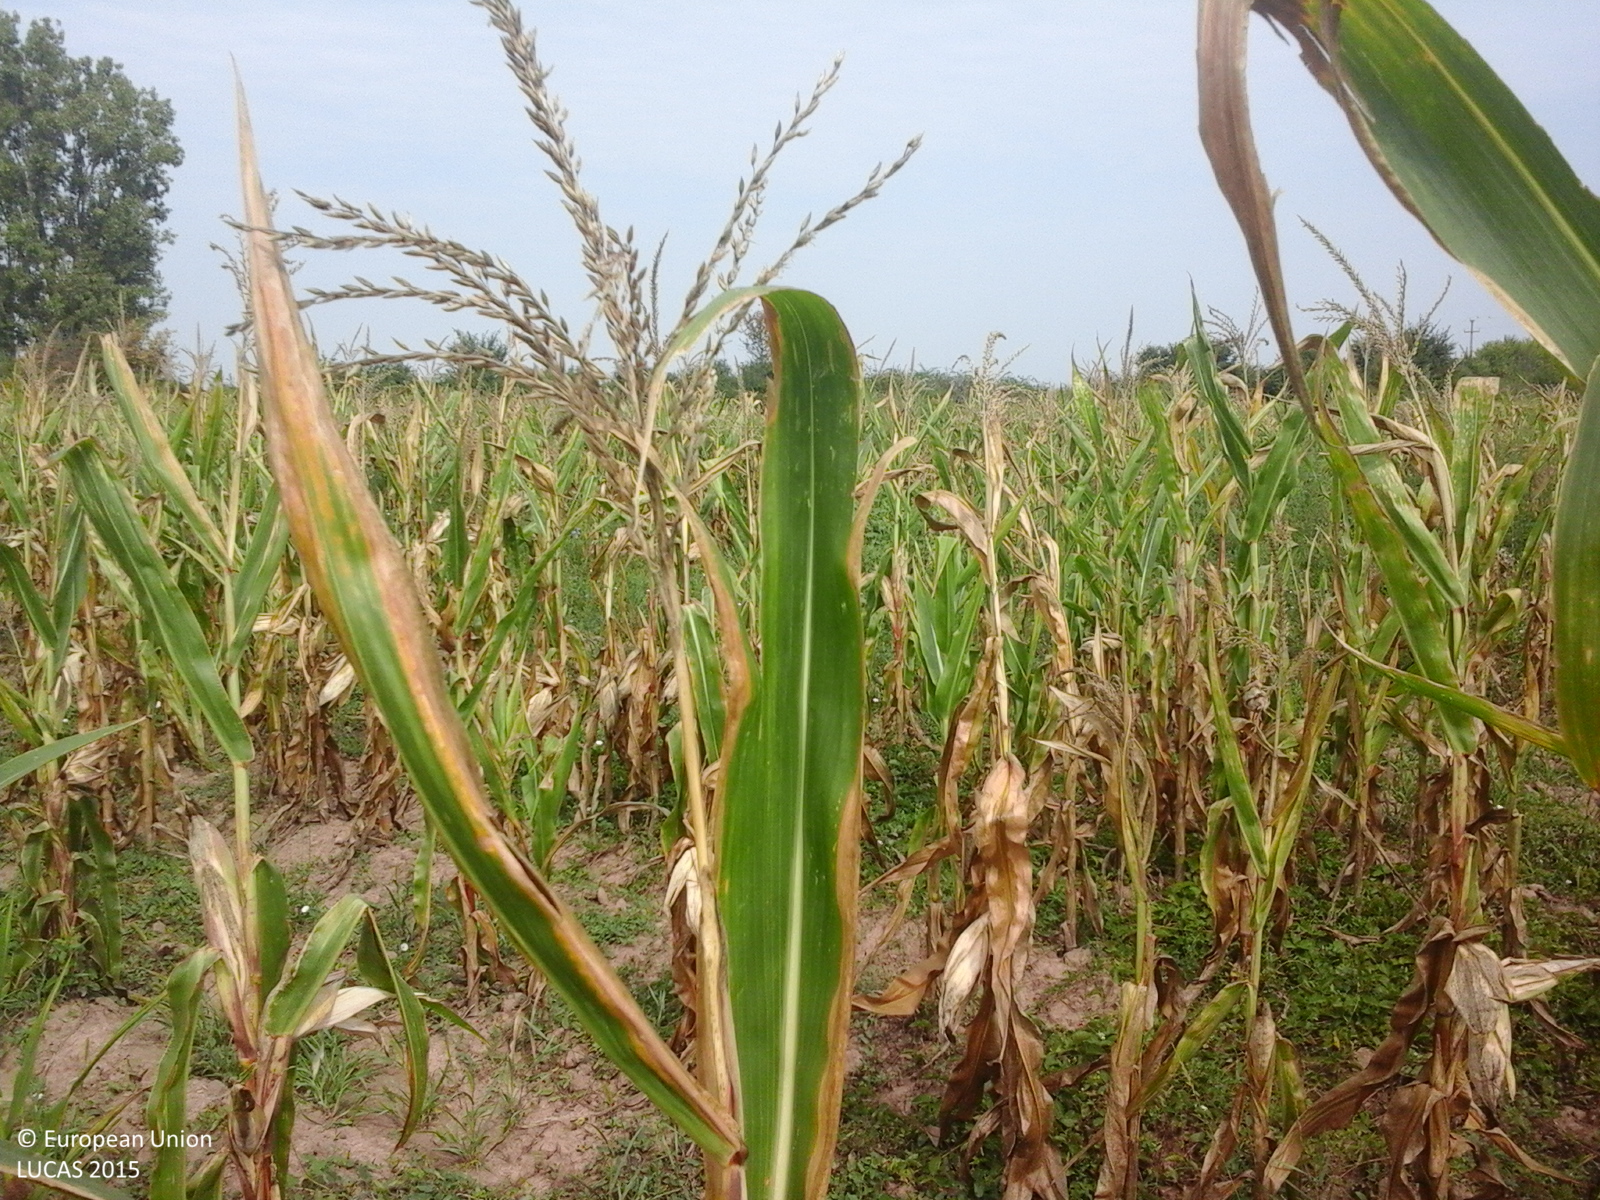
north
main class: Cropland
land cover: Maize
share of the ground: > 75 %
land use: Agriculture (excluding fallow land and kitchen gardens)
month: August
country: RO
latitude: 46.5954
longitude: 21.7236
